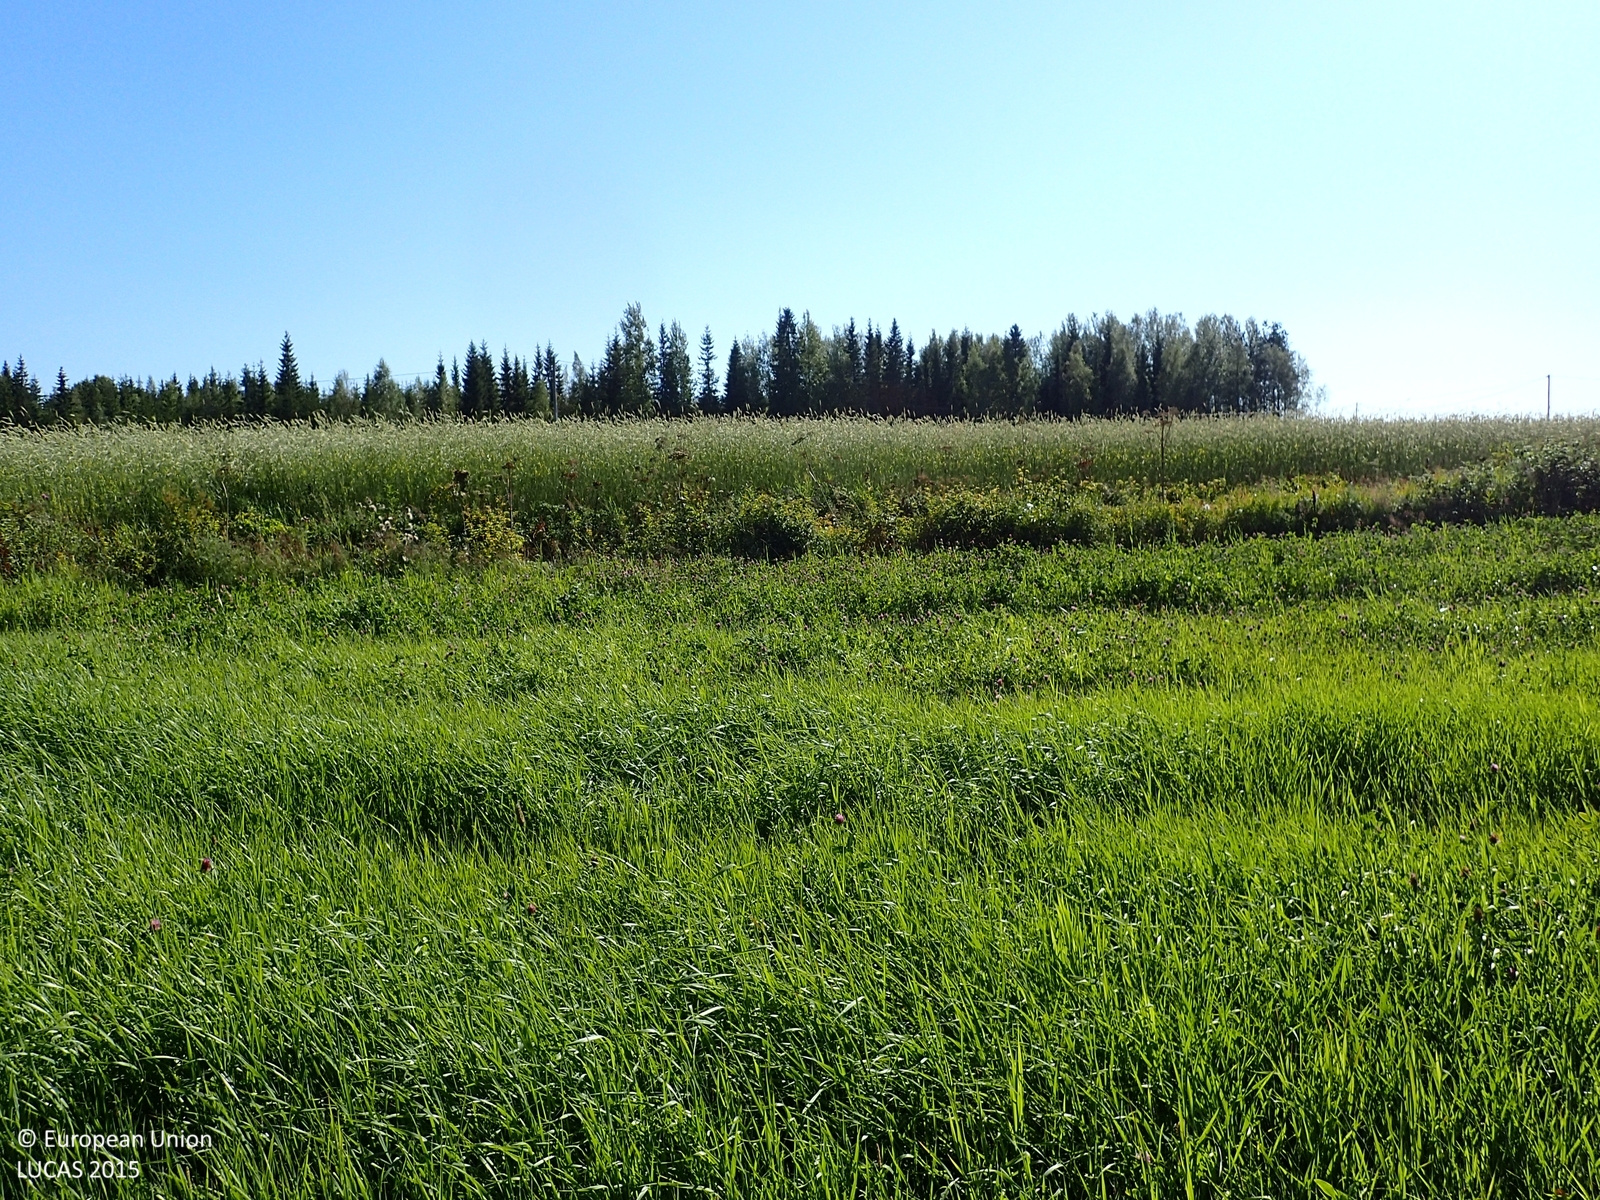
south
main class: Cropland
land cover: Temporary grasslands
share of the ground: > 75 %
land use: Agriculture (excluding fallow land and kitchen gardens)
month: August
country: FI
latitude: 62.3969
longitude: 21.8687
